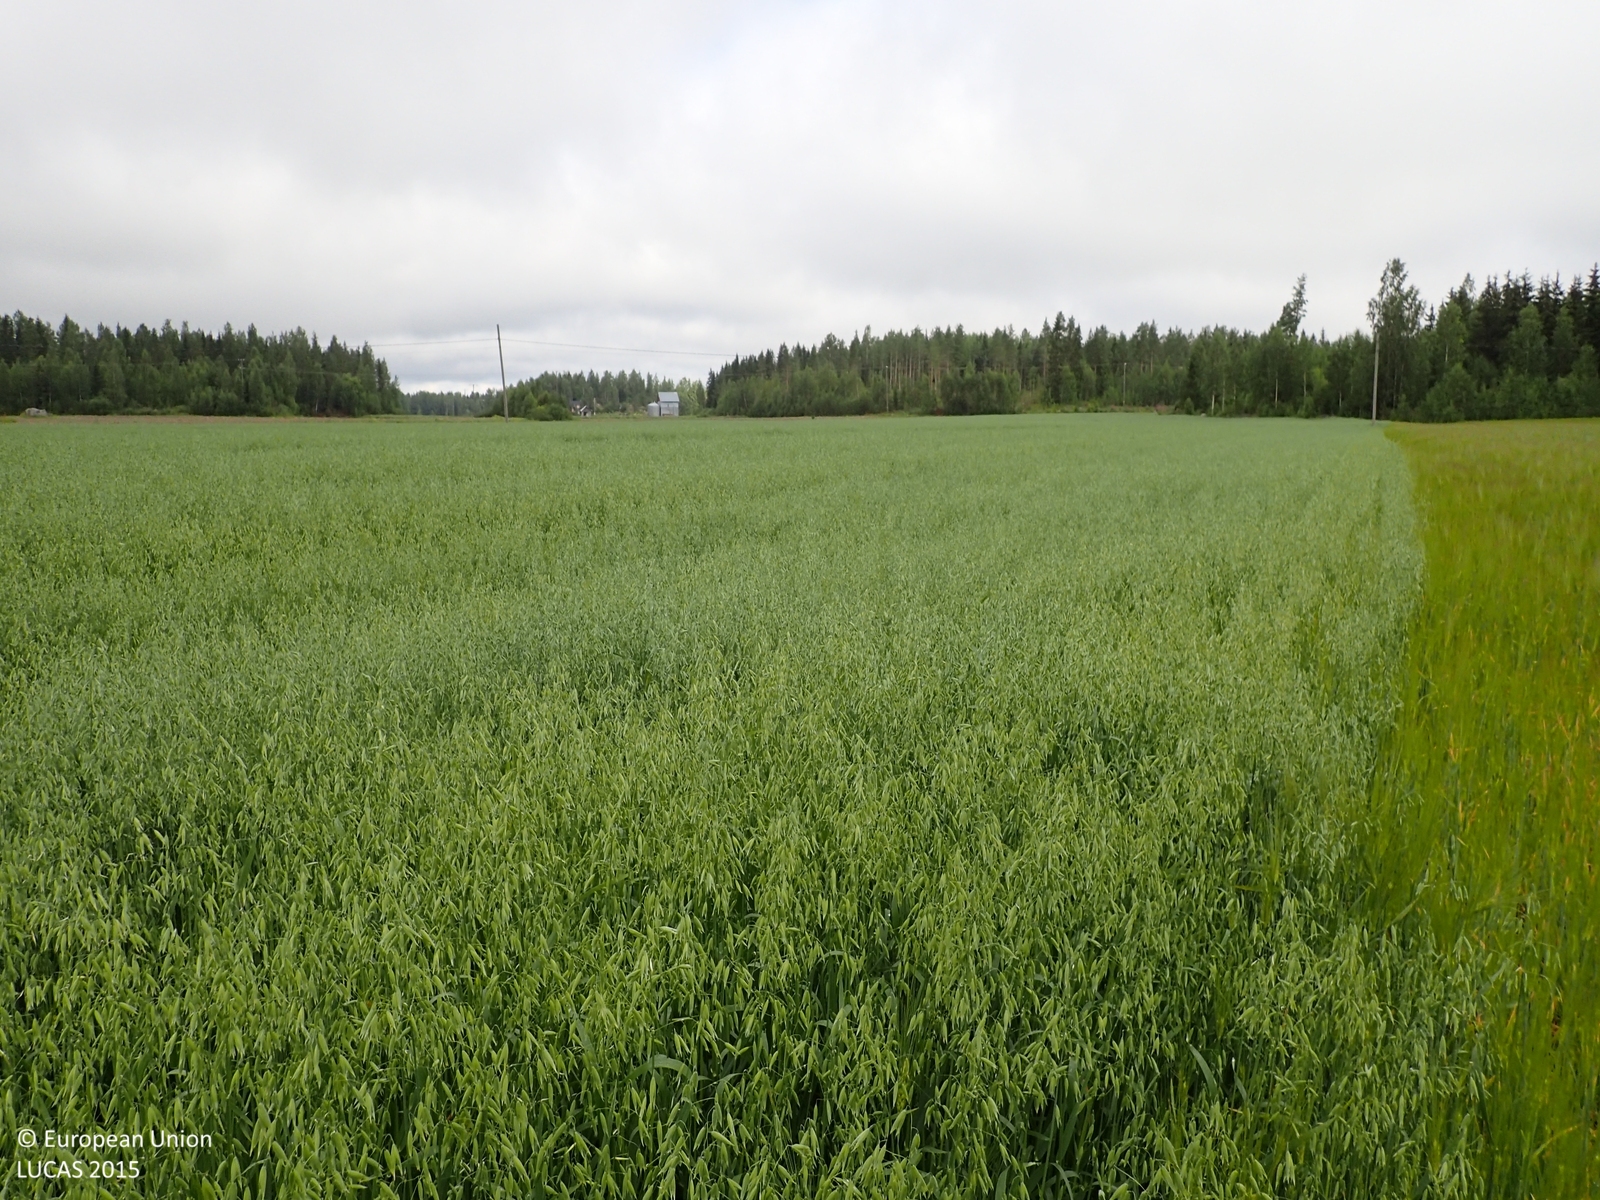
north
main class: Cropland
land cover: Oats
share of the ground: > 75 %
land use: Agriculture (excluding fallow land and kitchen gardens)
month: July
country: FI
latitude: 62.9679
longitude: 22.4964
